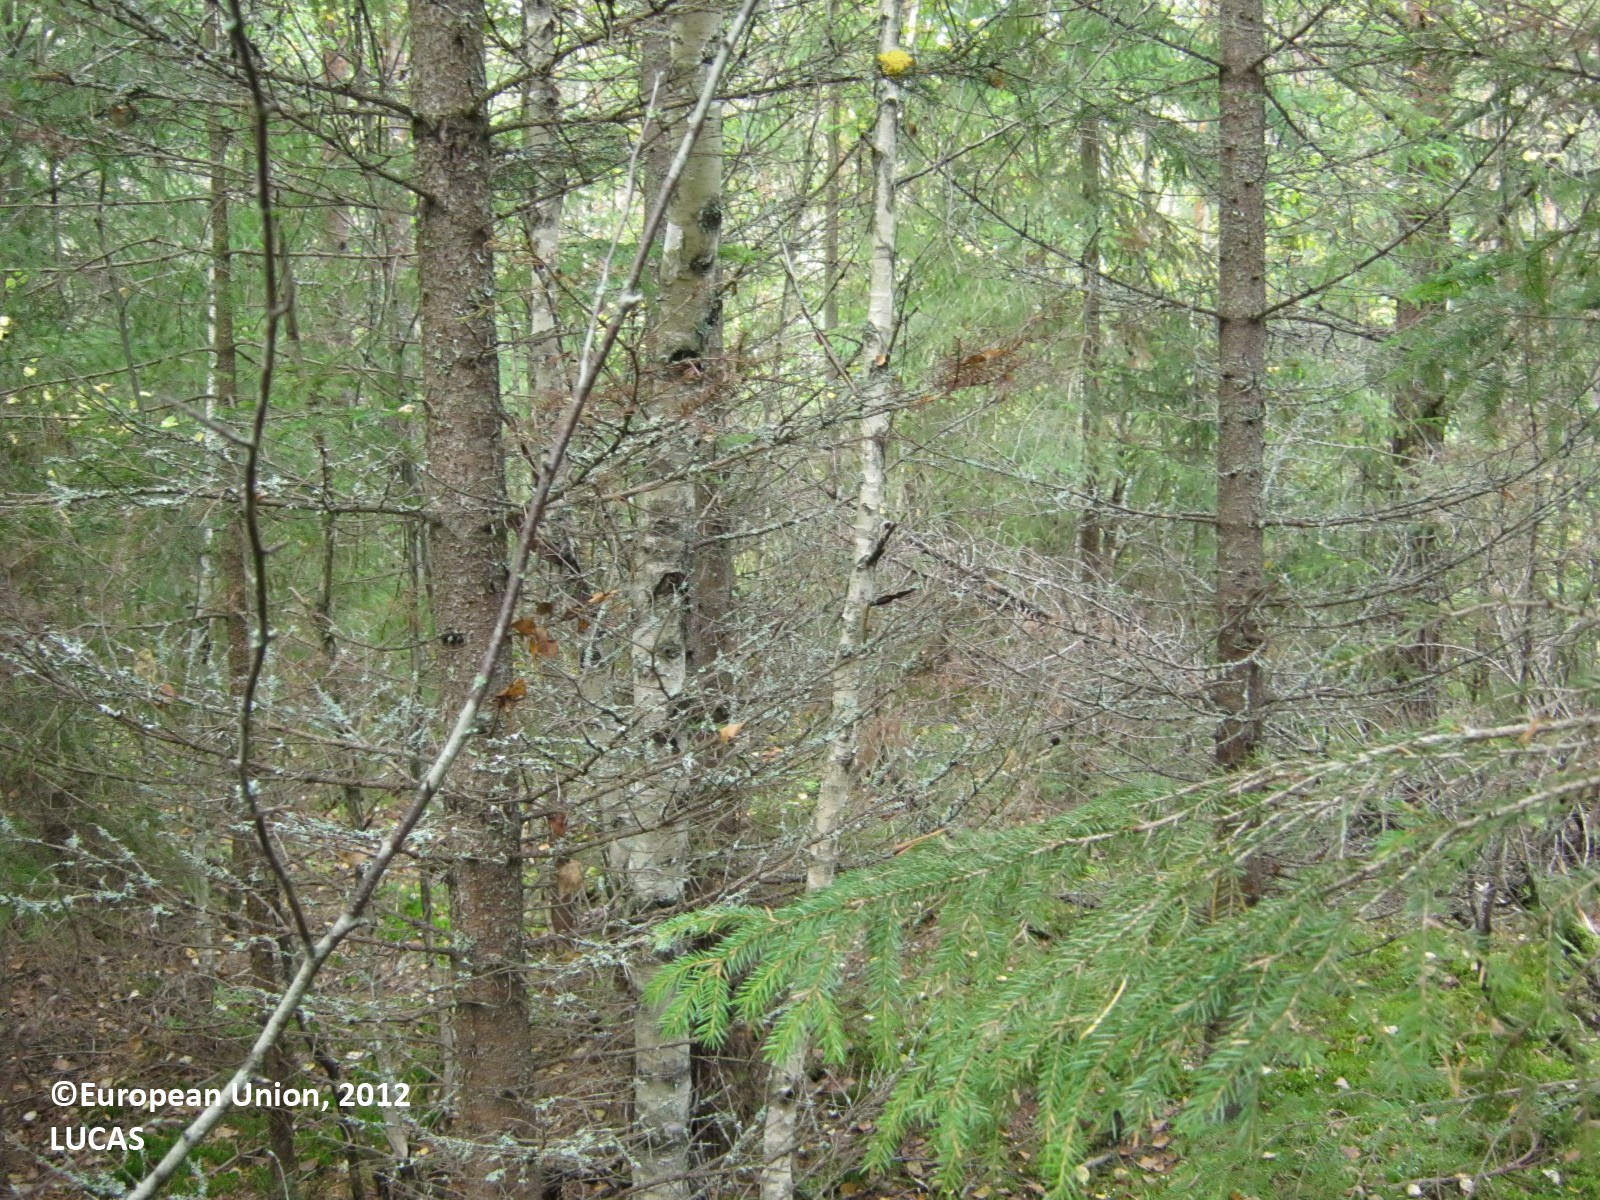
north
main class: Woodland
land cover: Other coniferous woodland
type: boreal forest
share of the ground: > 75 %
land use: Forestry
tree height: > 5 m
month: September
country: FI
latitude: 60.7108
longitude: 27.7290
